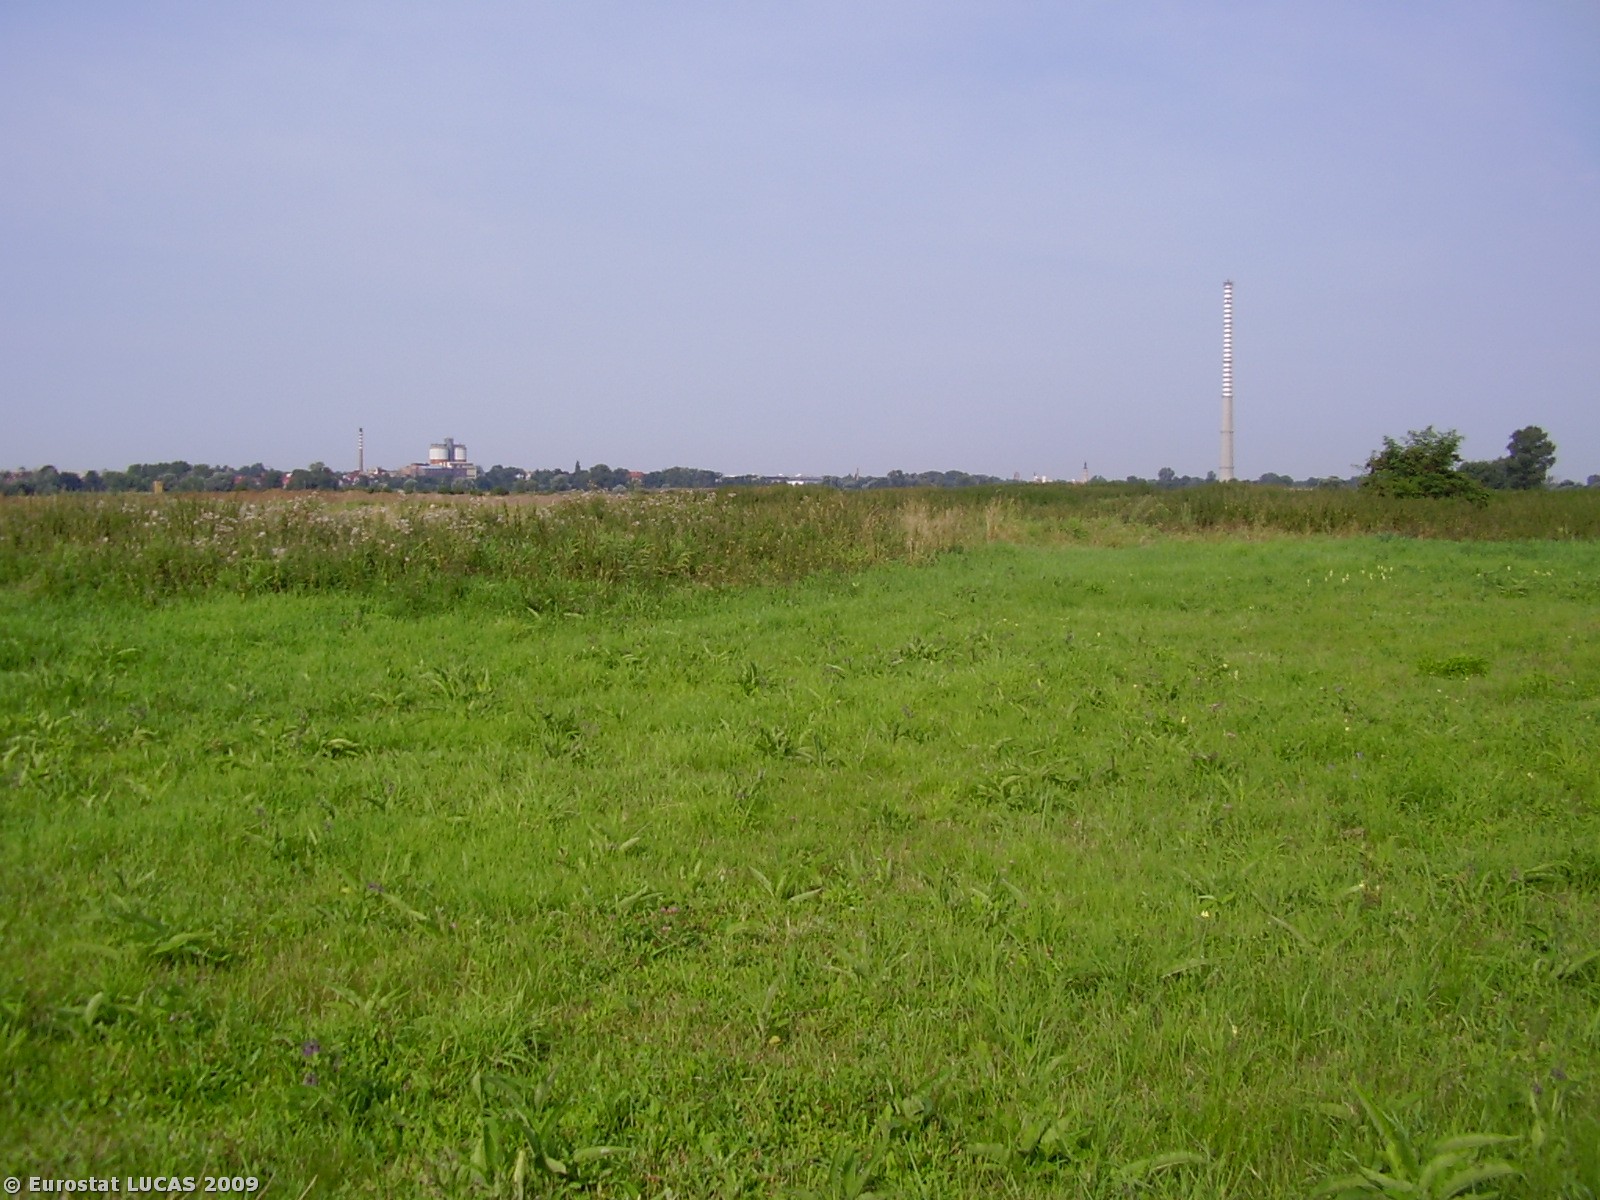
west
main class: Grassland
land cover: Grassland without tree/shrub cover
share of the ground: > 75 %
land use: Agriculture (excluding fallow land and kitchen gardens)
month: August
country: PL
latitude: 51.6591
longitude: 16.1502
